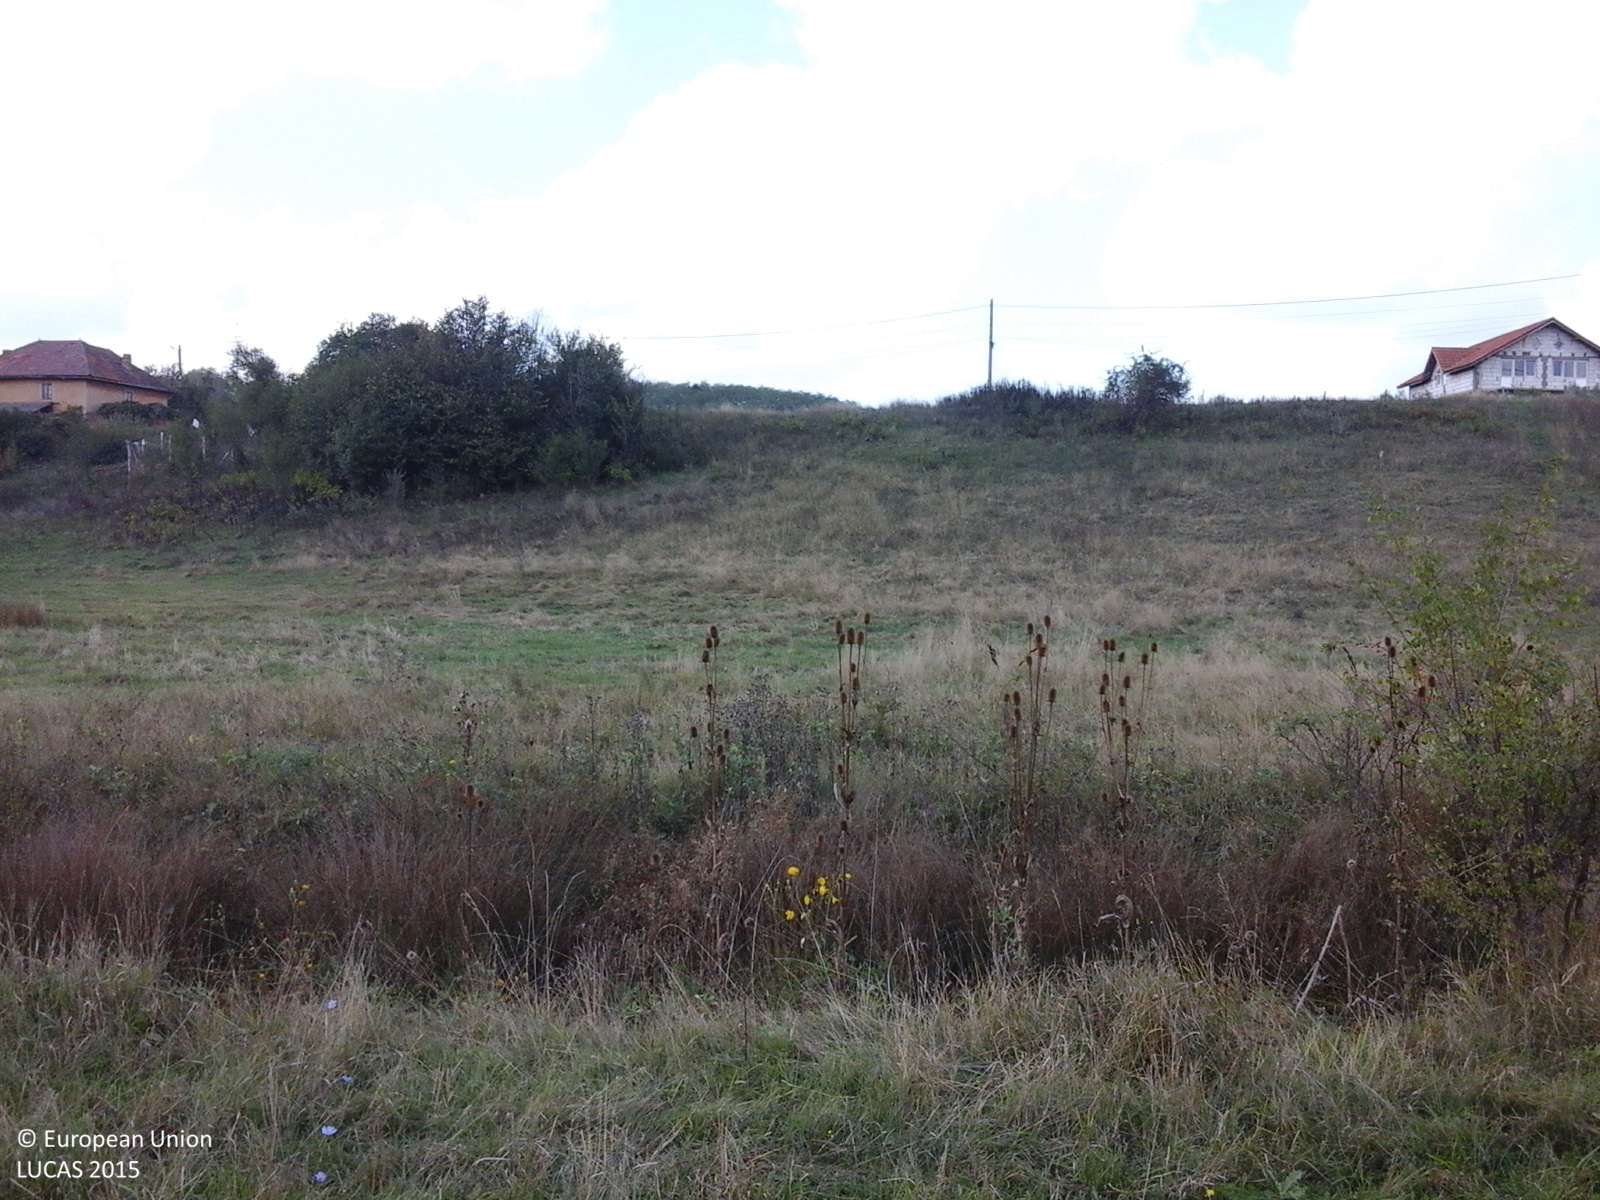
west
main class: Grassland
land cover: Grassland without tree/shrub cover
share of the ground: > 75 %
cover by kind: herbaceous plants 100 %
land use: Agriculture (excluding fallow land and kitchen gardens)
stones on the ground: < 10 %
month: September
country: RO
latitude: 44.9924
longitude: 23.5412
